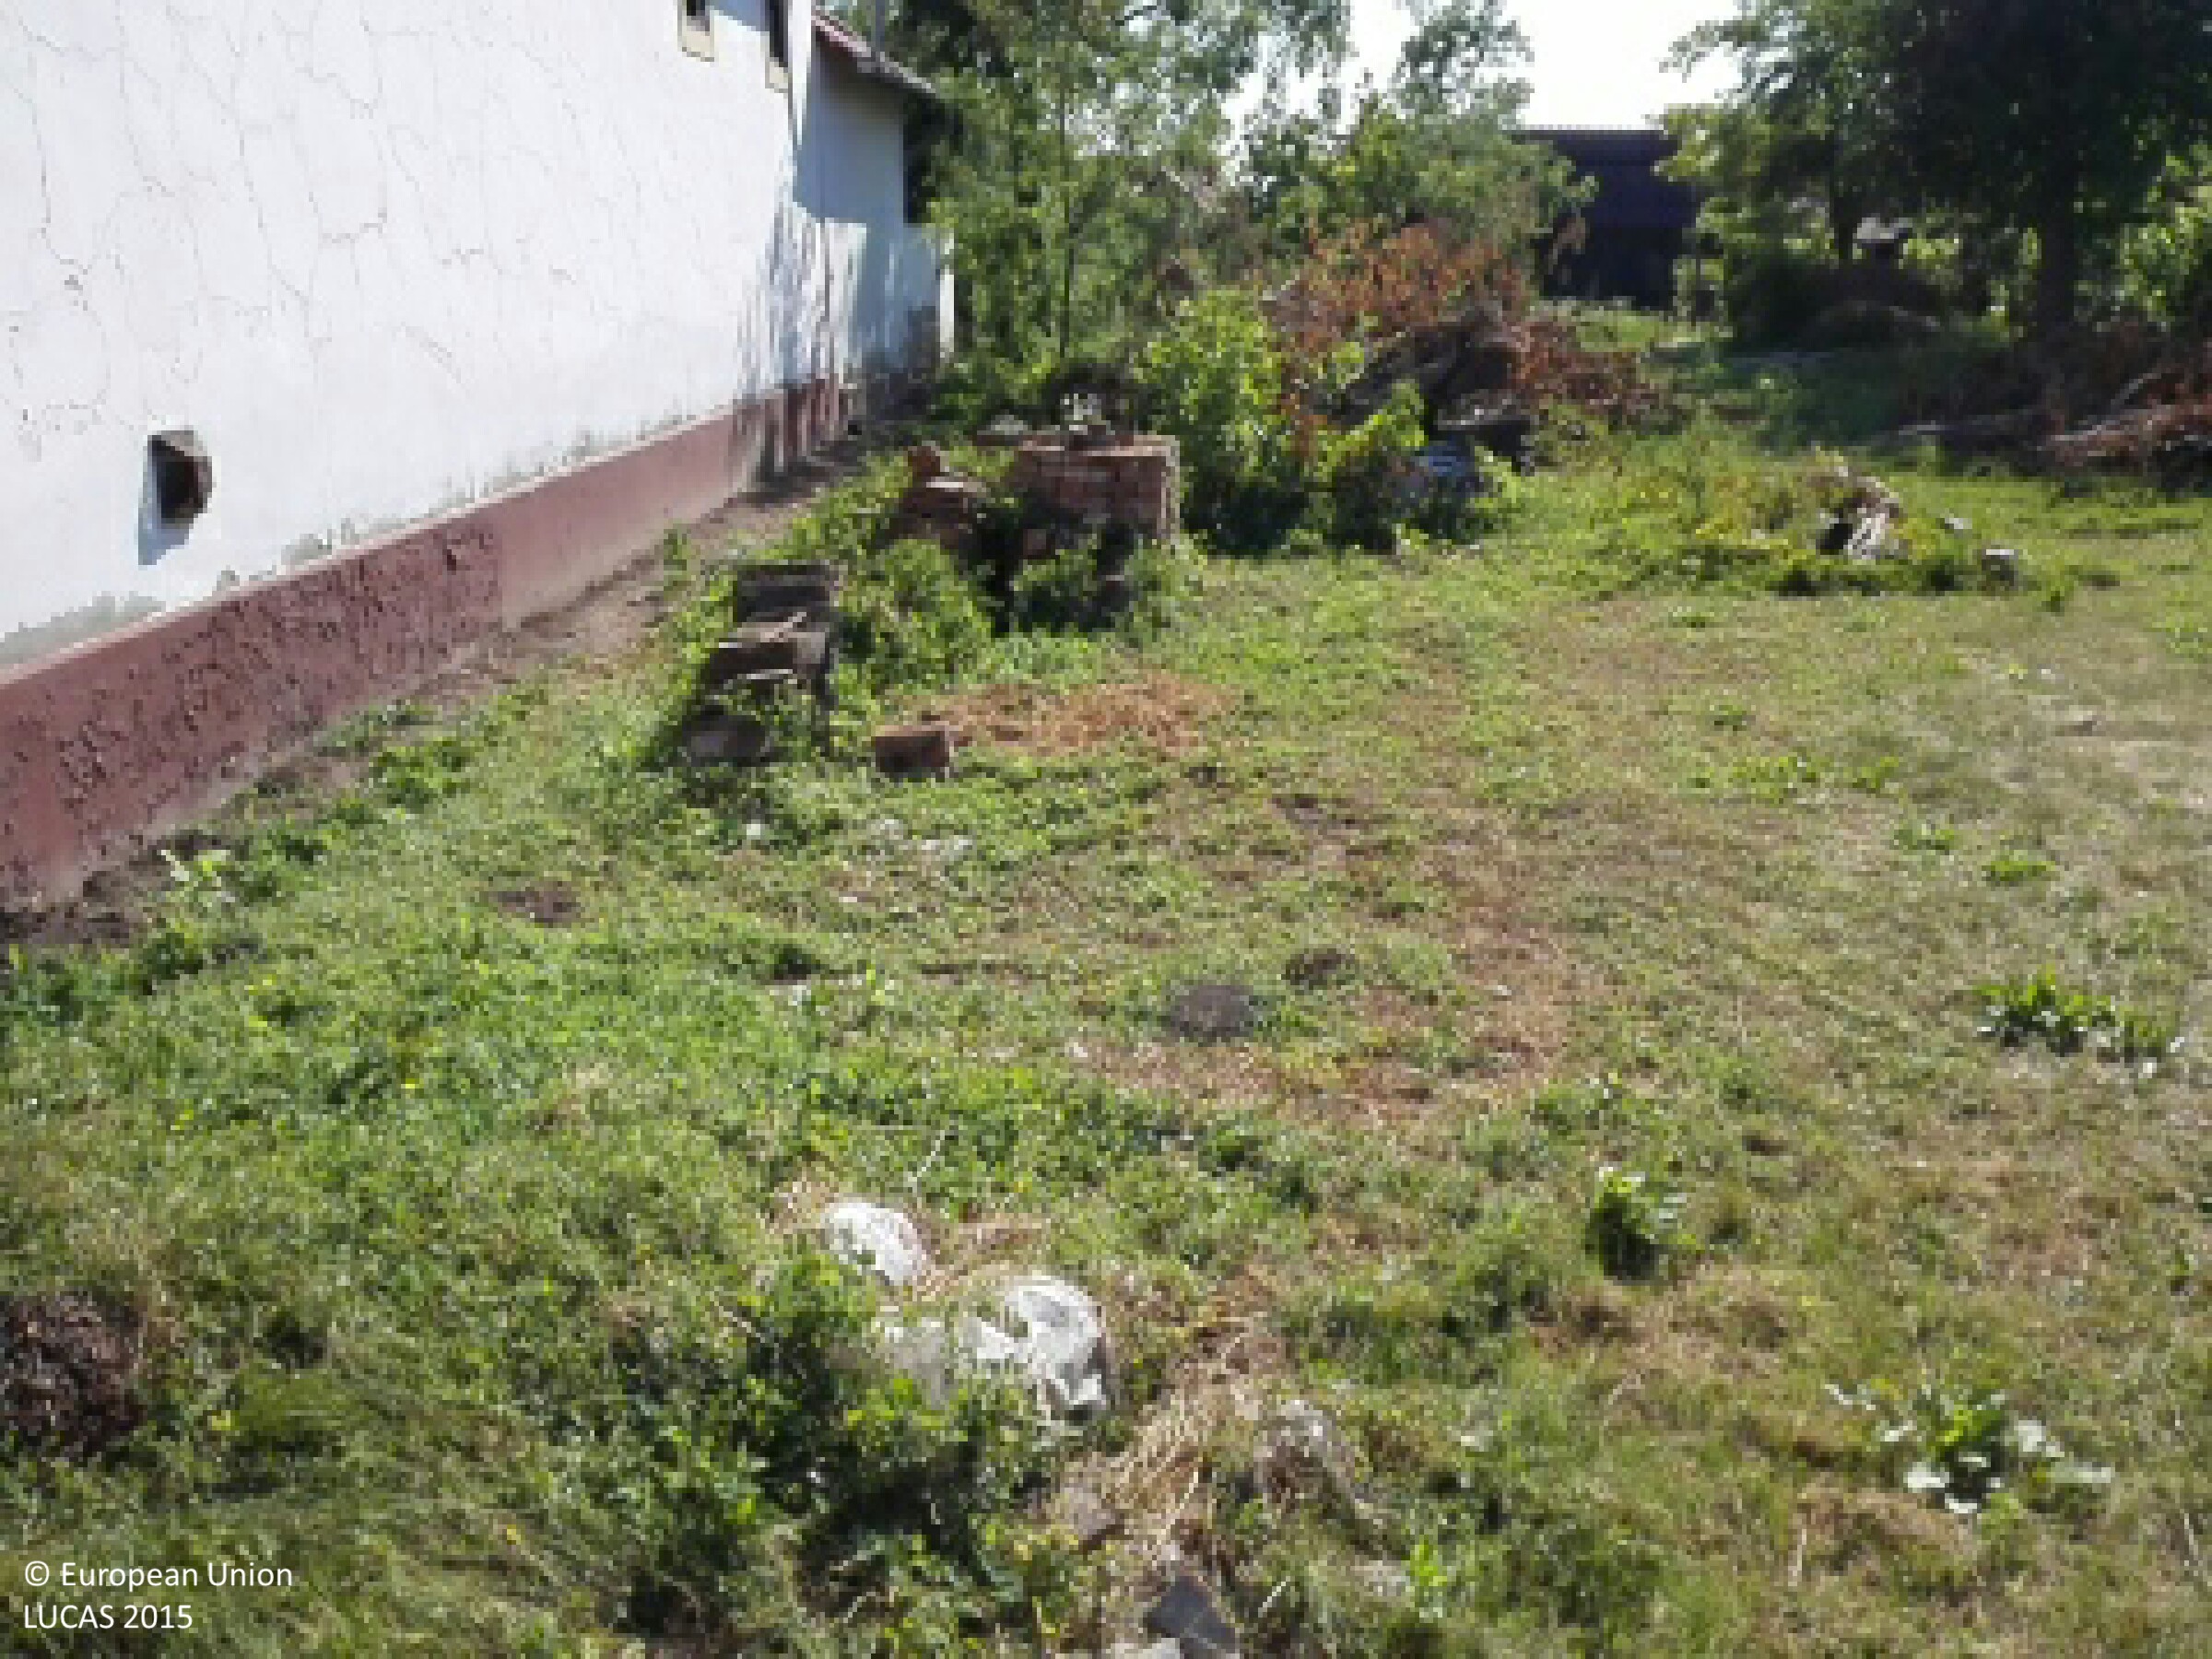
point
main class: Grassland
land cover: Grassland without tree/shrub cover
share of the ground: > 75 %
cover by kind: herbaceous plants 95 %, unconsolidated bare surface 5 %
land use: Residential
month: July
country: HU
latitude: 47.3520
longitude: 21.2785
